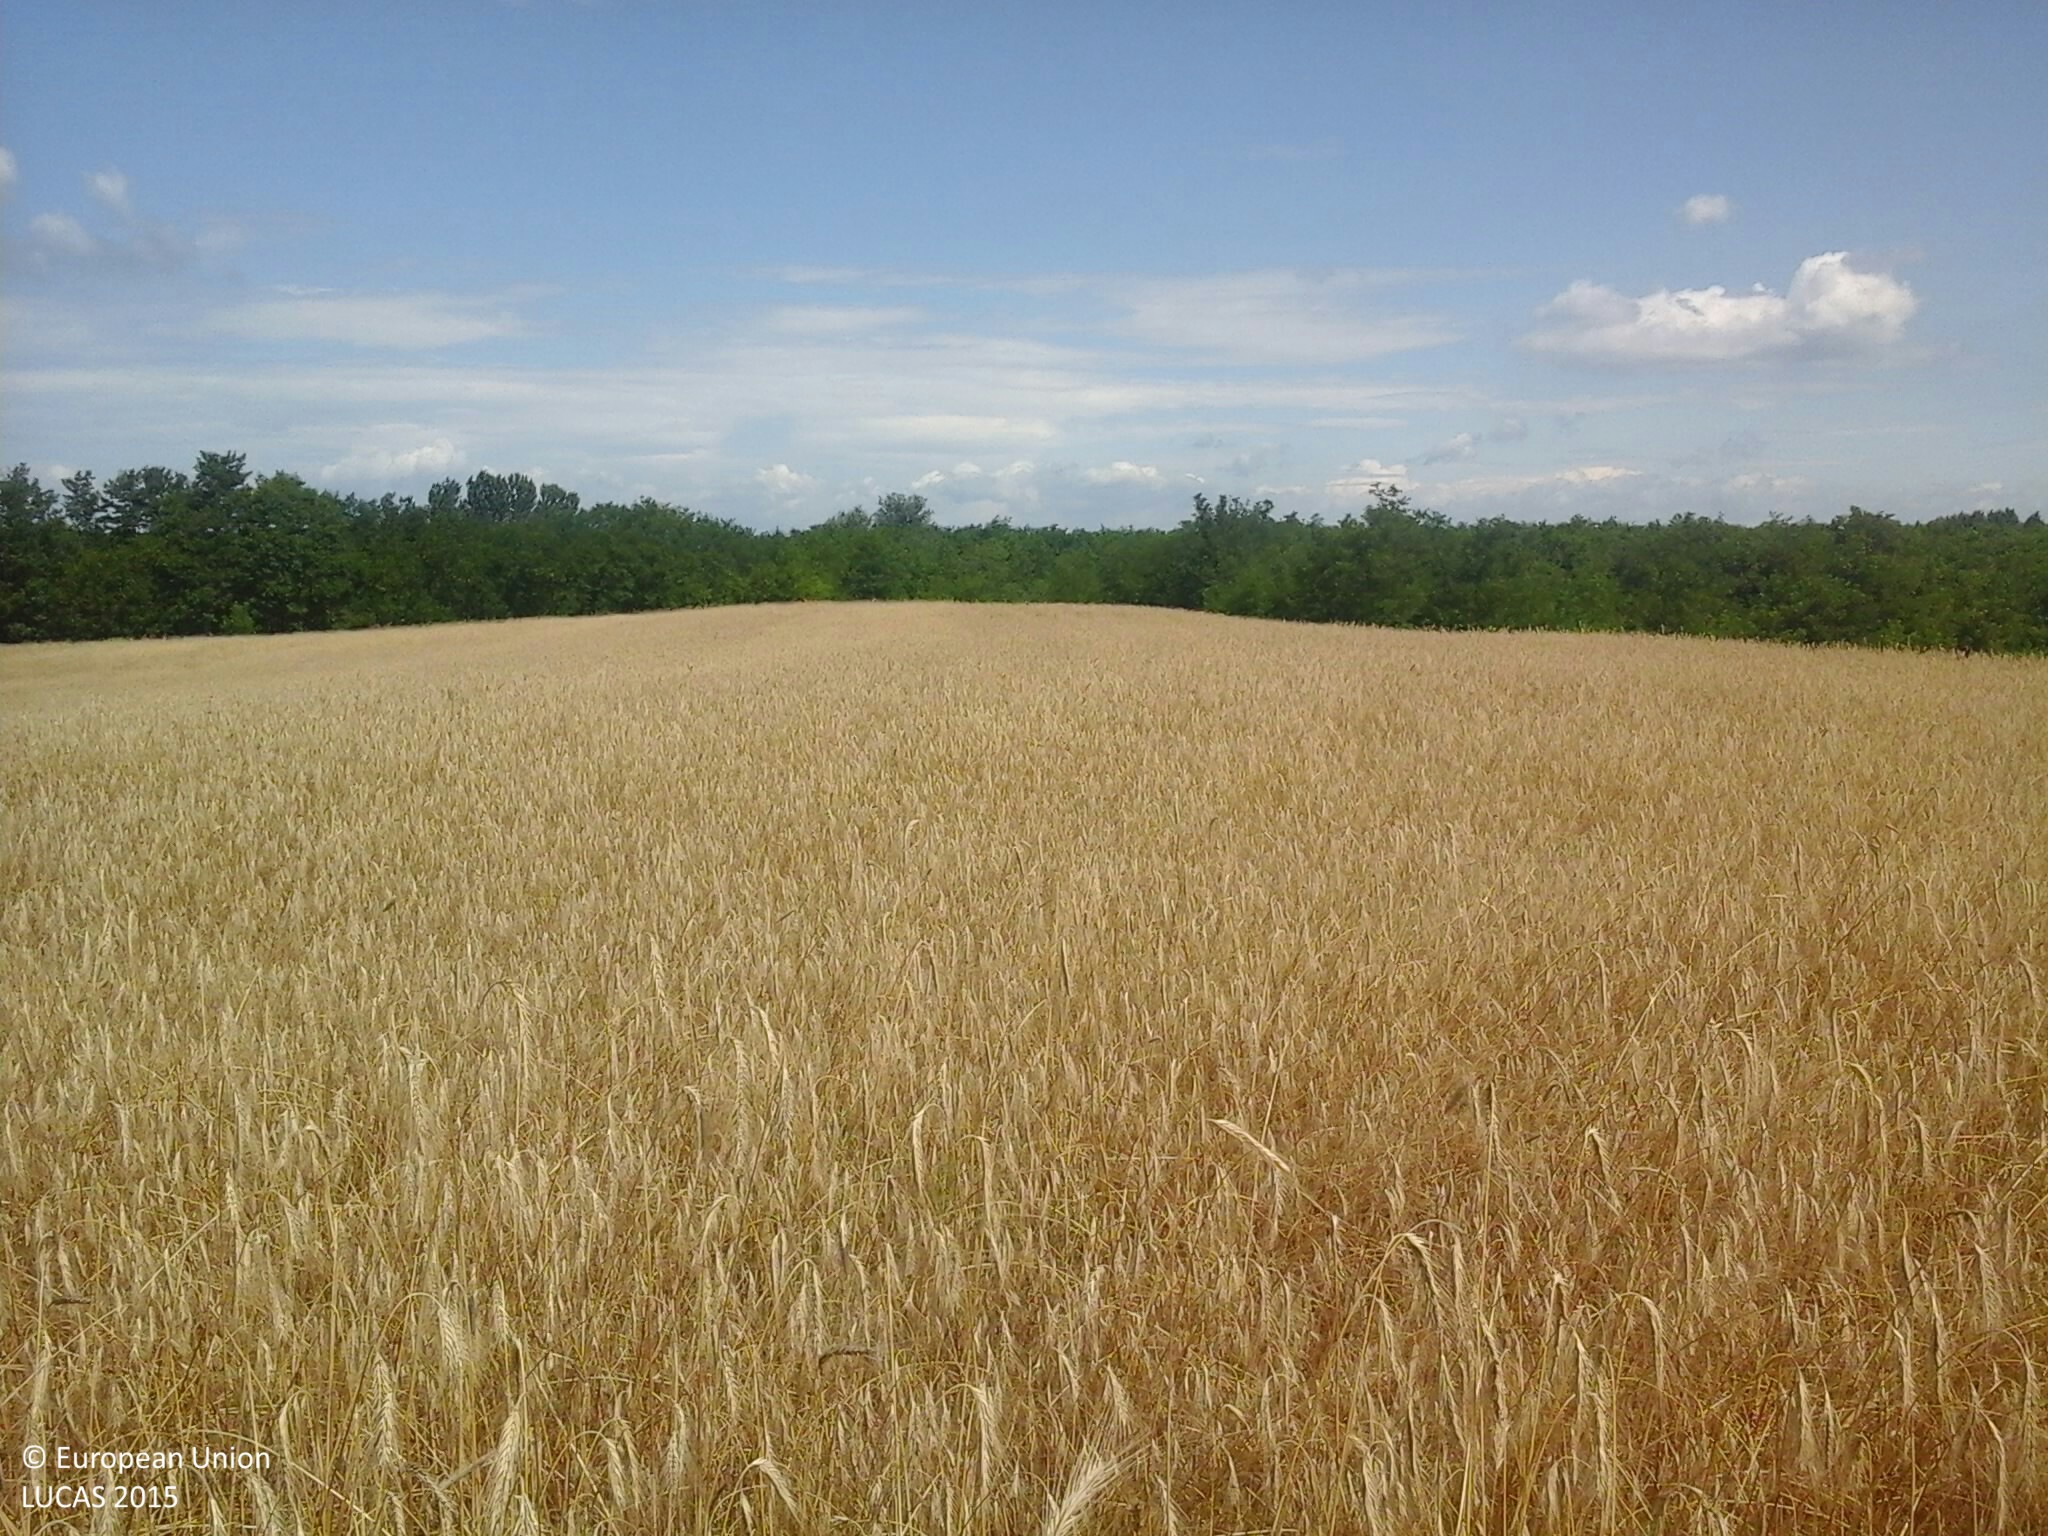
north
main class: Cropland
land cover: Triticale
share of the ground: > 75 %
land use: Agriculture (excluding fallow land and kitchen gardens)
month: July
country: HU
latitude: 47.8815
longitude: 22.2641
